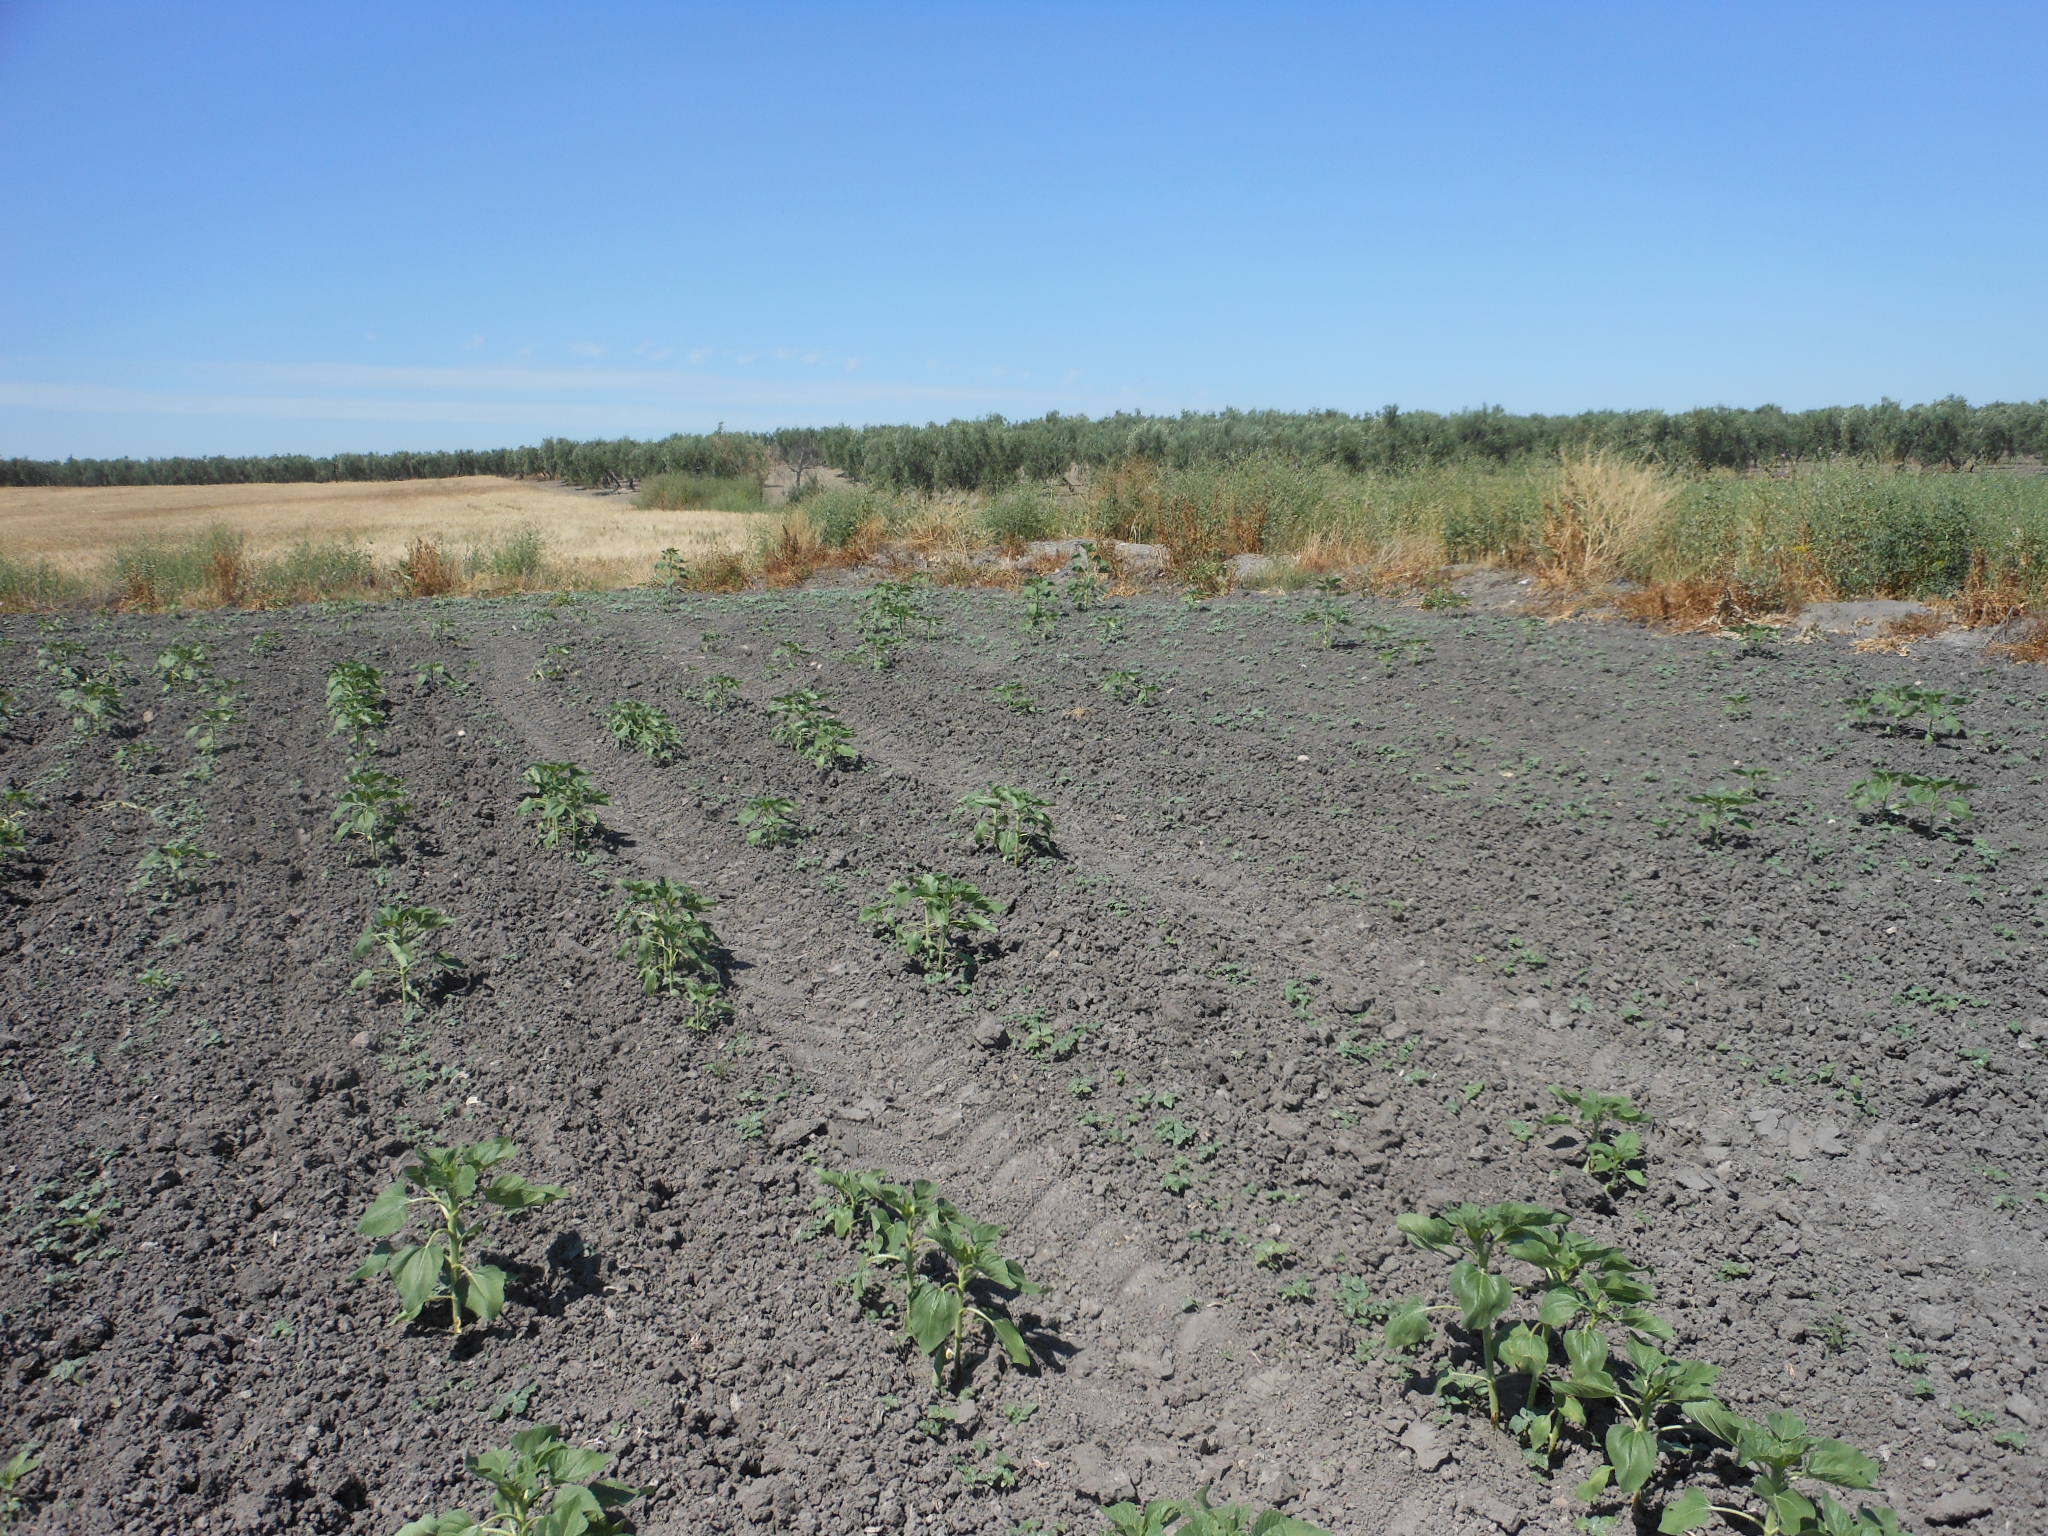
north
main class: Cropland
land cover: Sunflower
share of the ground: 10 - 25 %
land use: Agriculture (excluding fallow land and kitchen gardens)
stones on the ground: < 10 %
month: May
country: ES
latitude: 37.2895
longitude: -5.5473
